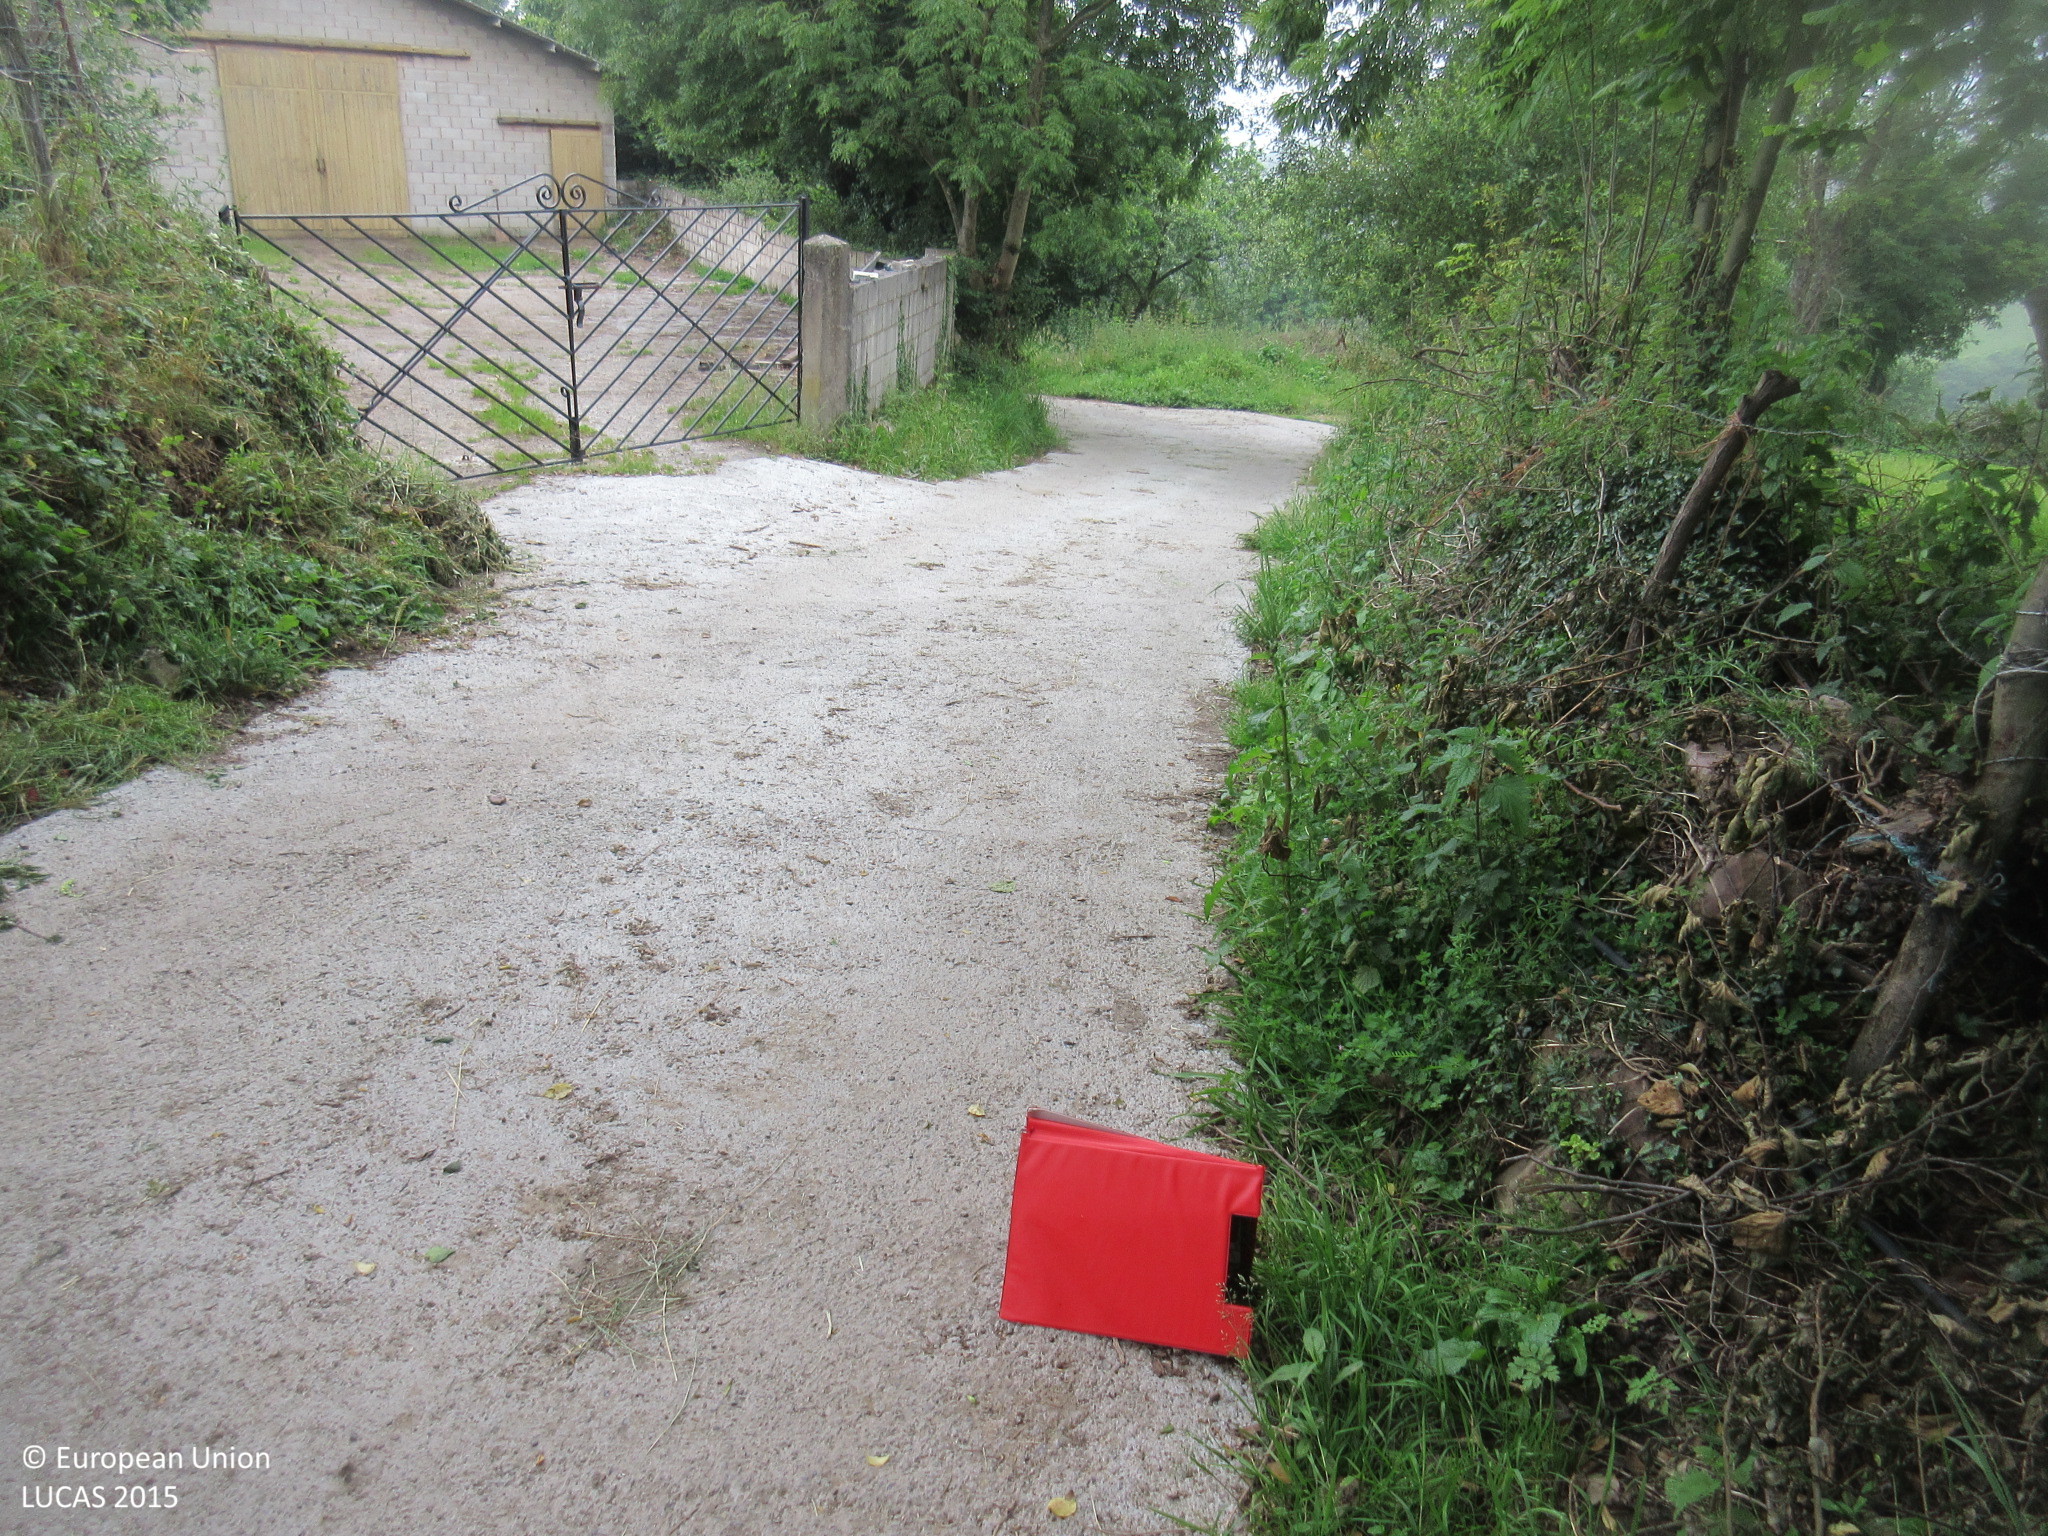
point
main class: Grassland
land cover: Grassland without tree/shrub cover
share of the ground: > 75 %
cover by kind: herbaceous plants 100 %
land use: Agriculture (excluding fallow land and kitchen gardens)
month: June
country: ES
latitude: 43.2893
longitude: -6.3044
